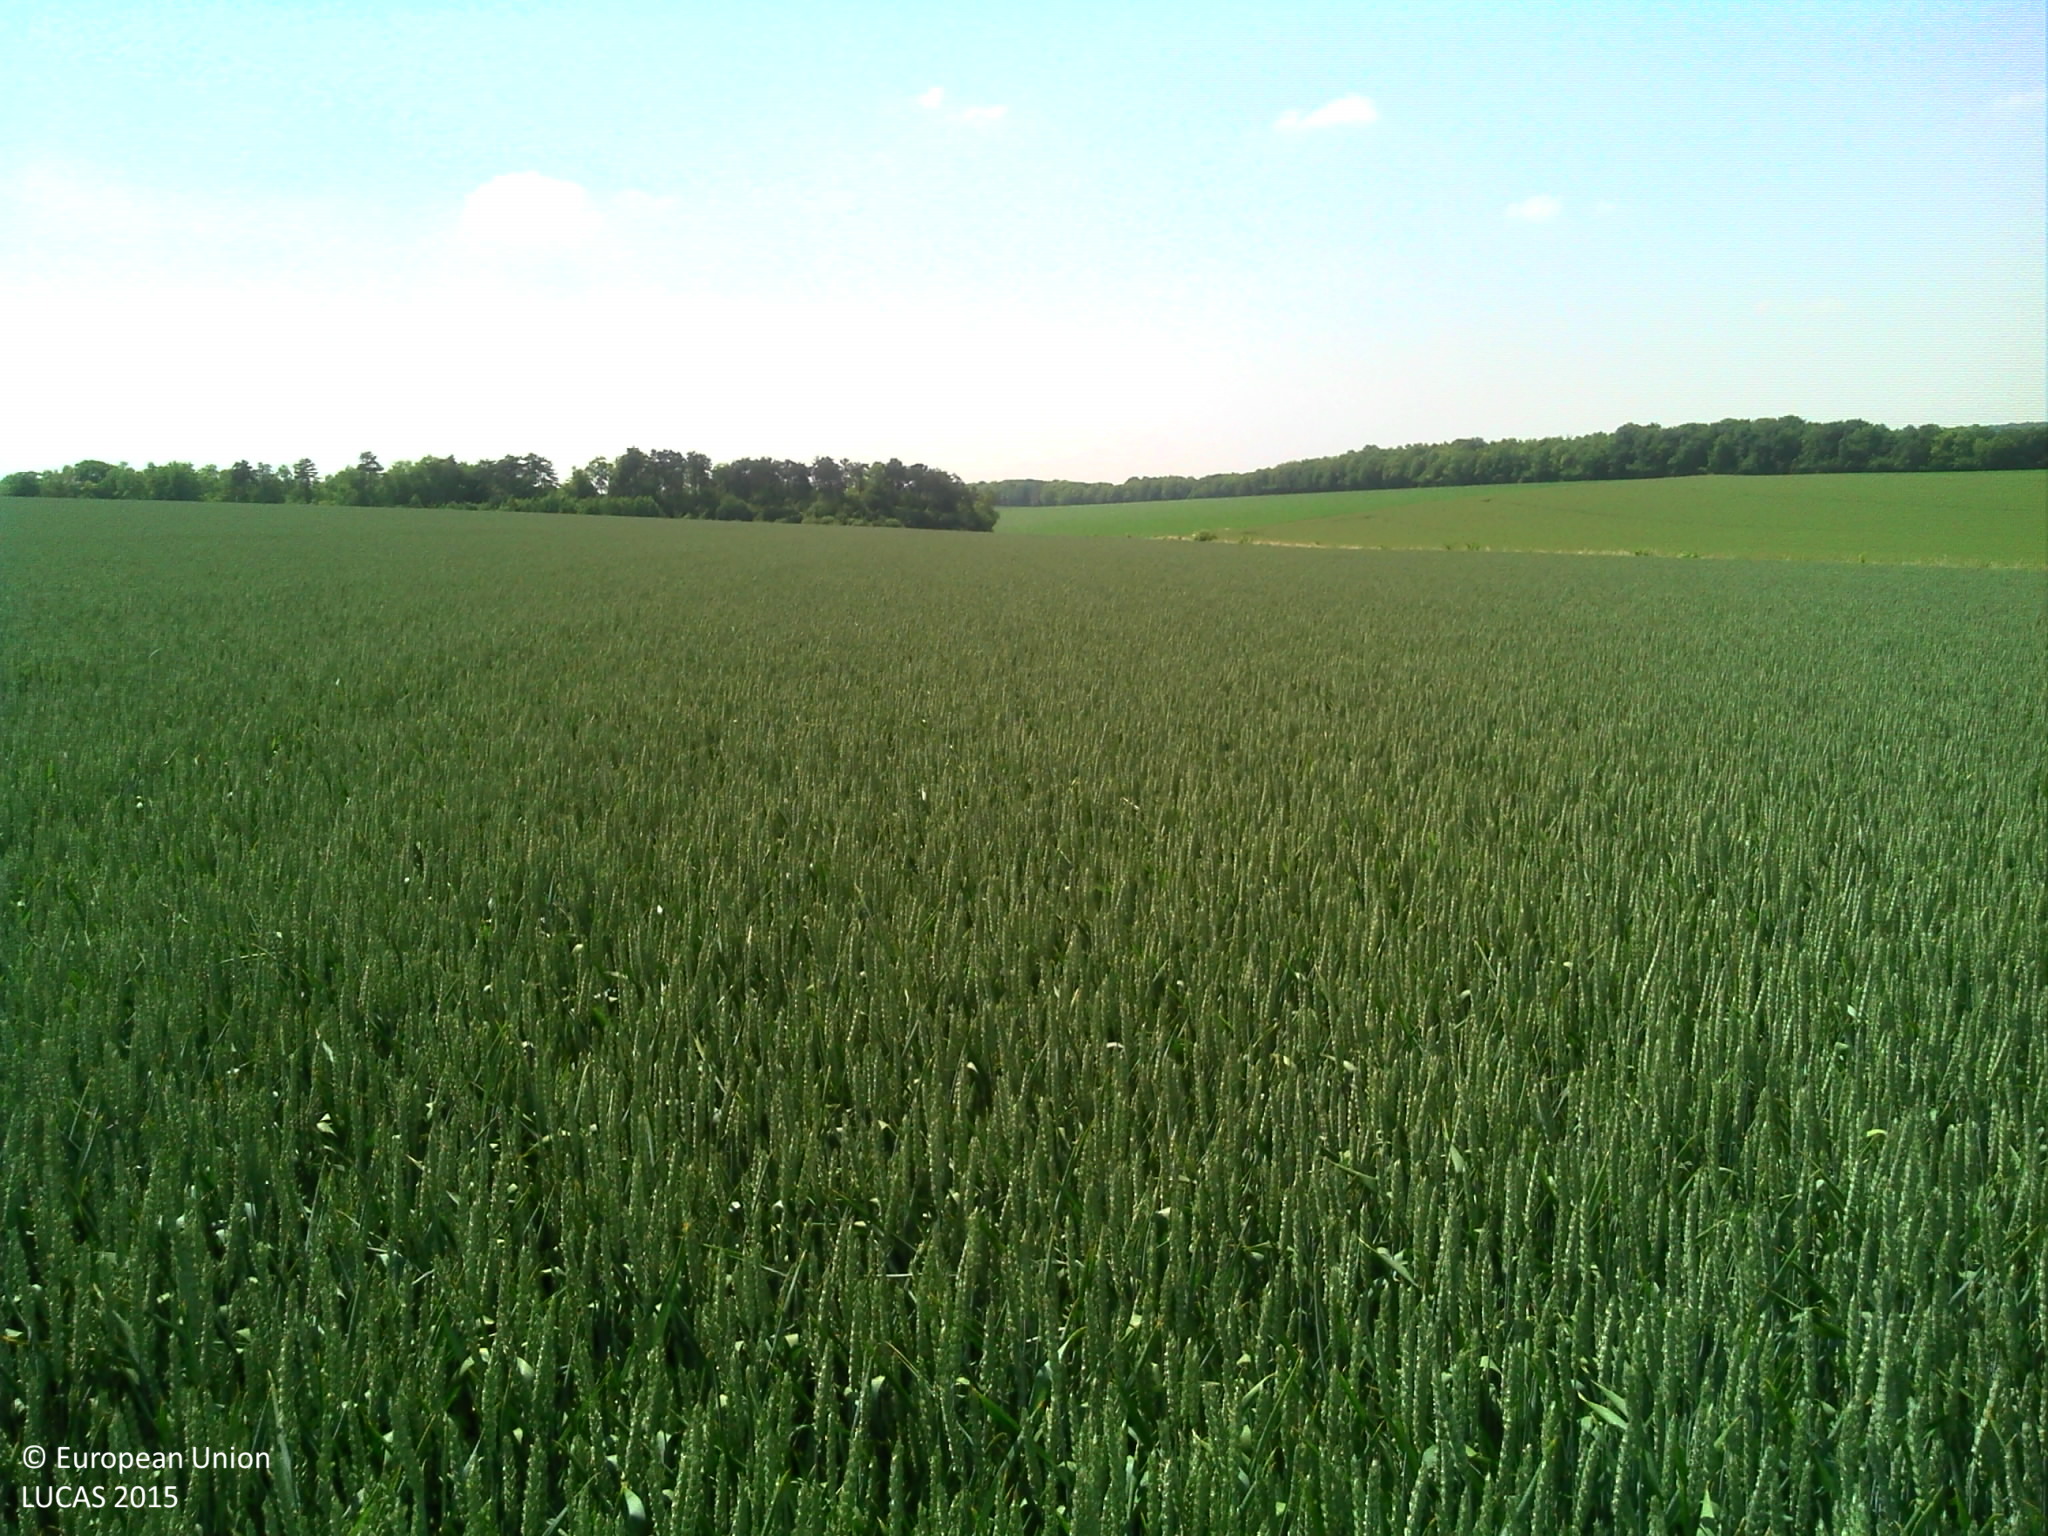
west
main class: Cropland
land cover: Common wheat
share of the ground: > 75 %
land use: Agriculture (excluding fallow land and kitchen gardens)
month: June
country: FR
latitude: 49.5235
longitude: 4.0407
